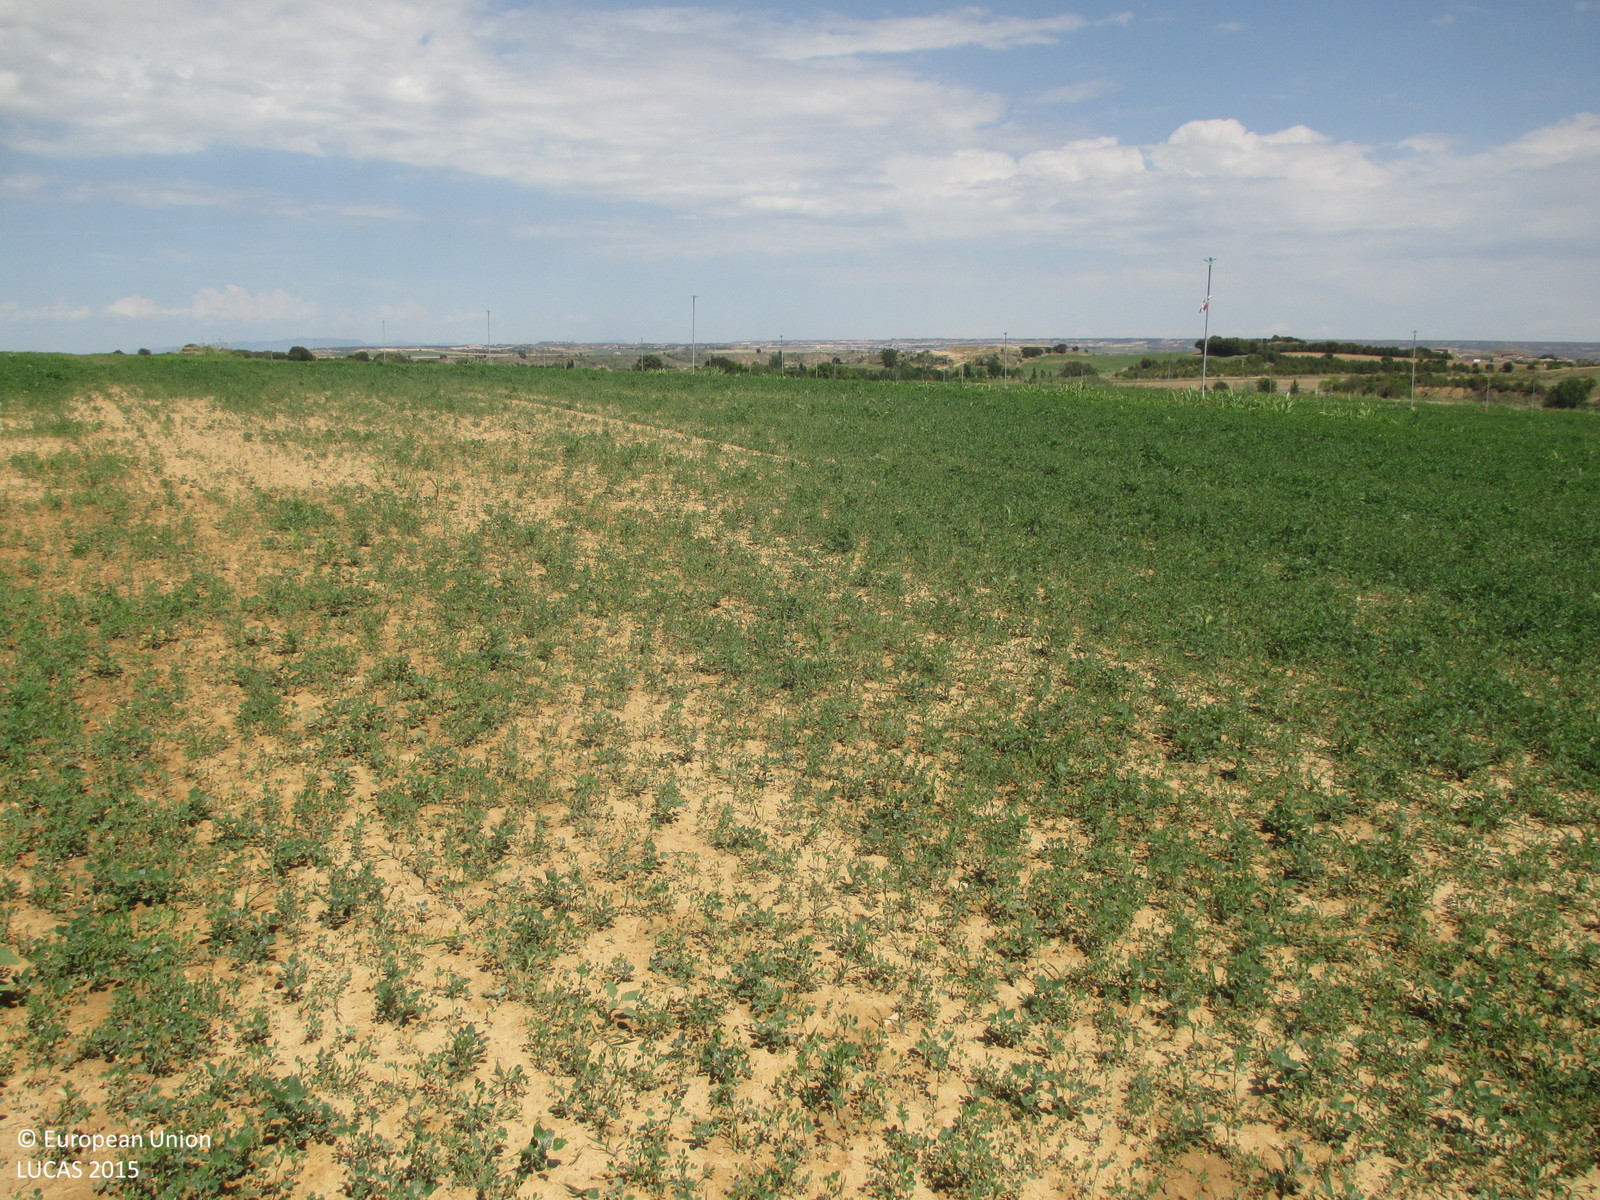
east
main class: Cropland
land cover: Lucerne
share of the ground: > 75 %
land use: Agriculture (excluding fallow land and kitchen gardens)
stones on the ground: < 10 %
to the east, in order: Lucerne; Grass margins; Barley
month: May
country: ES
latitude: 41.9390
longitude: -0.1871
